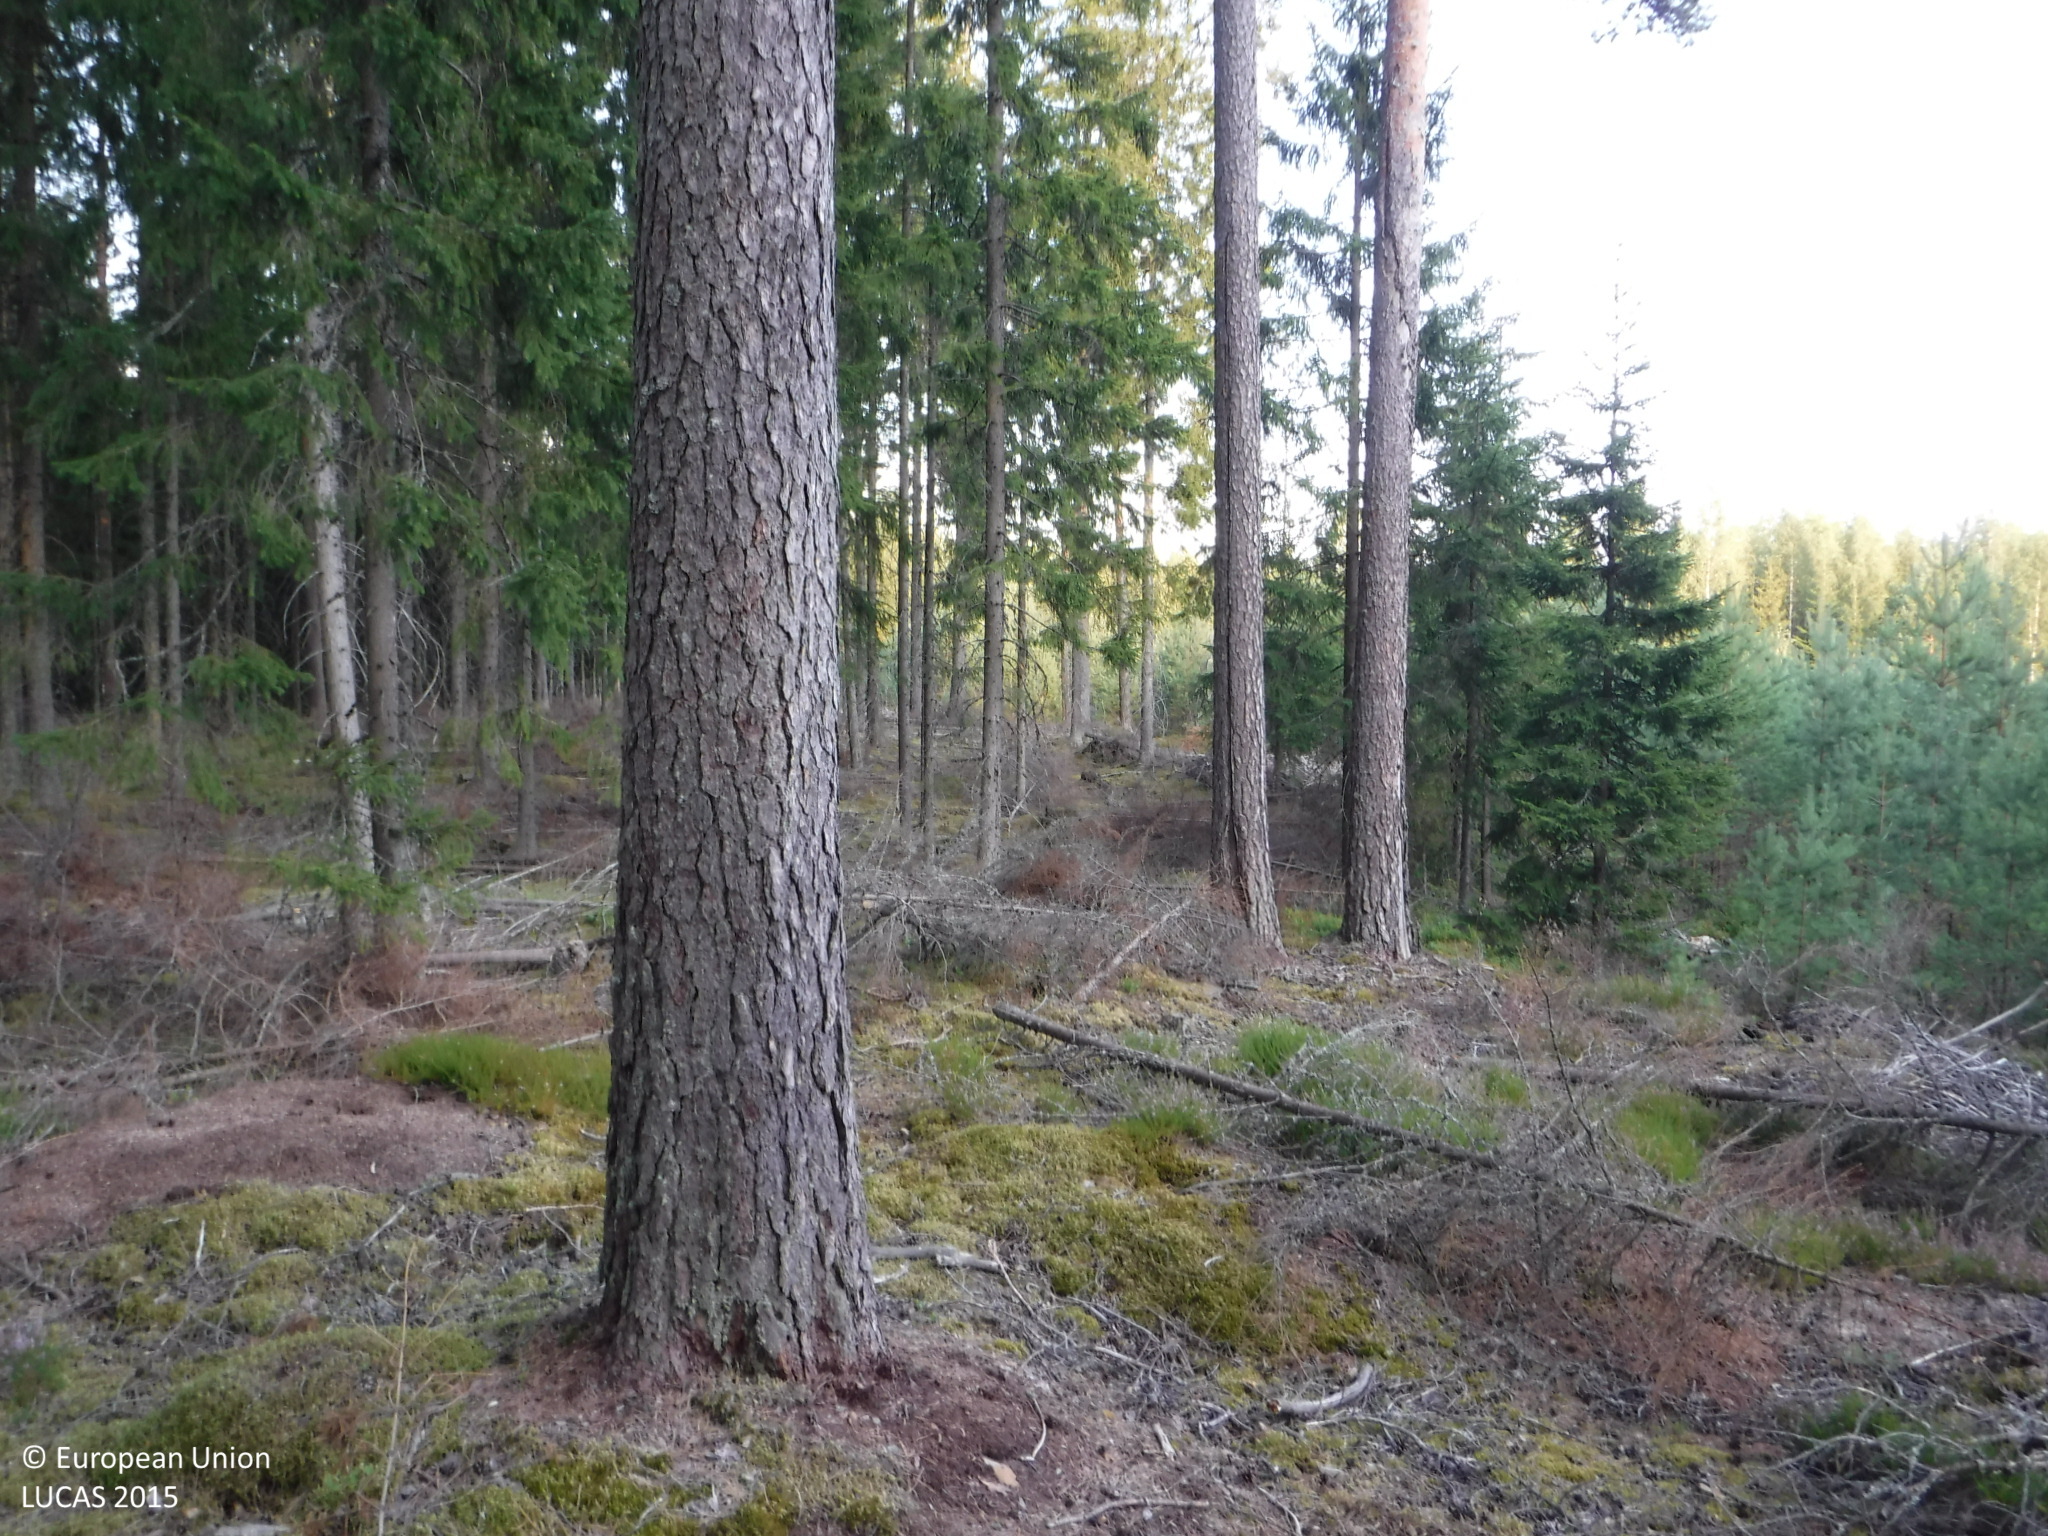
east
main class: Woodland
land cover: Other coniferous woodland
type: boreal forest
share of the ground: 25 - 50 %
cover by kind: coniferous forest trees 50 %, shrubs 30 %, lichens and mosses 20 %
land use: Forestry
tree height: > 5 m
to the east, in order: Other coniferous woodland; Tracks; Groves; Pine dominated coniferous woodland; Tracks
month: August
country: FI
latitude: 61.1610
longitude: 23.0654
